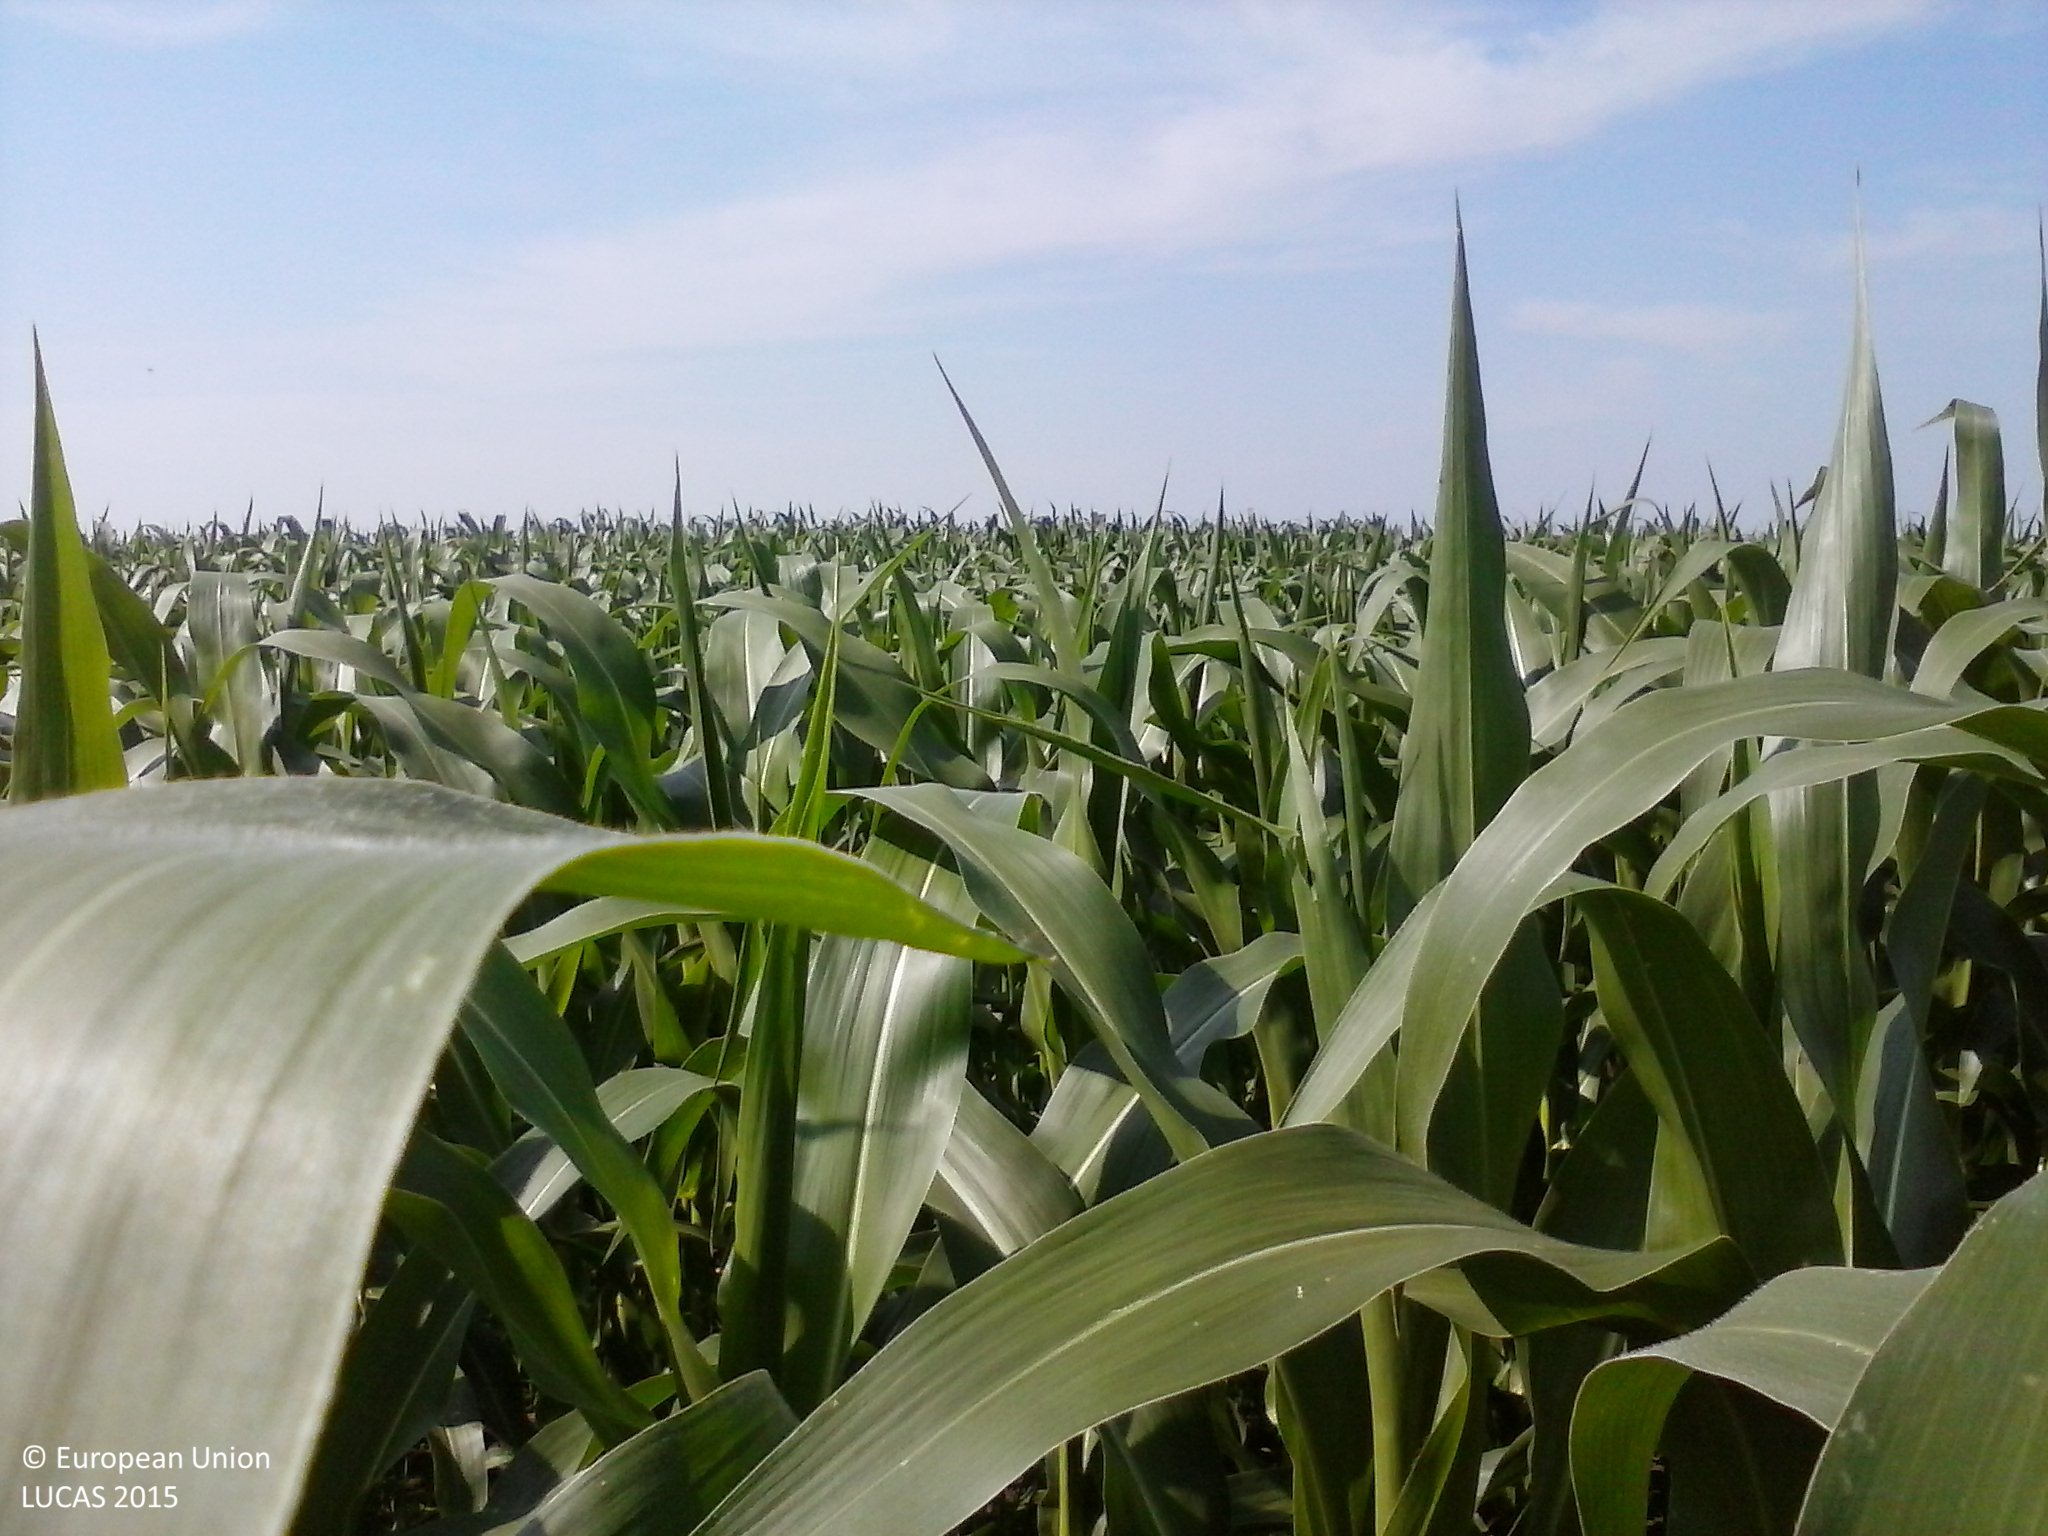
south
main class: Cropland
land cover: Maize
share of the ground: > 75 %
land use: Agriculture (excluding fallow land and kitchen gardens)
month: June
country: HU
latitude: 46.1624
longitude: 19.5087
